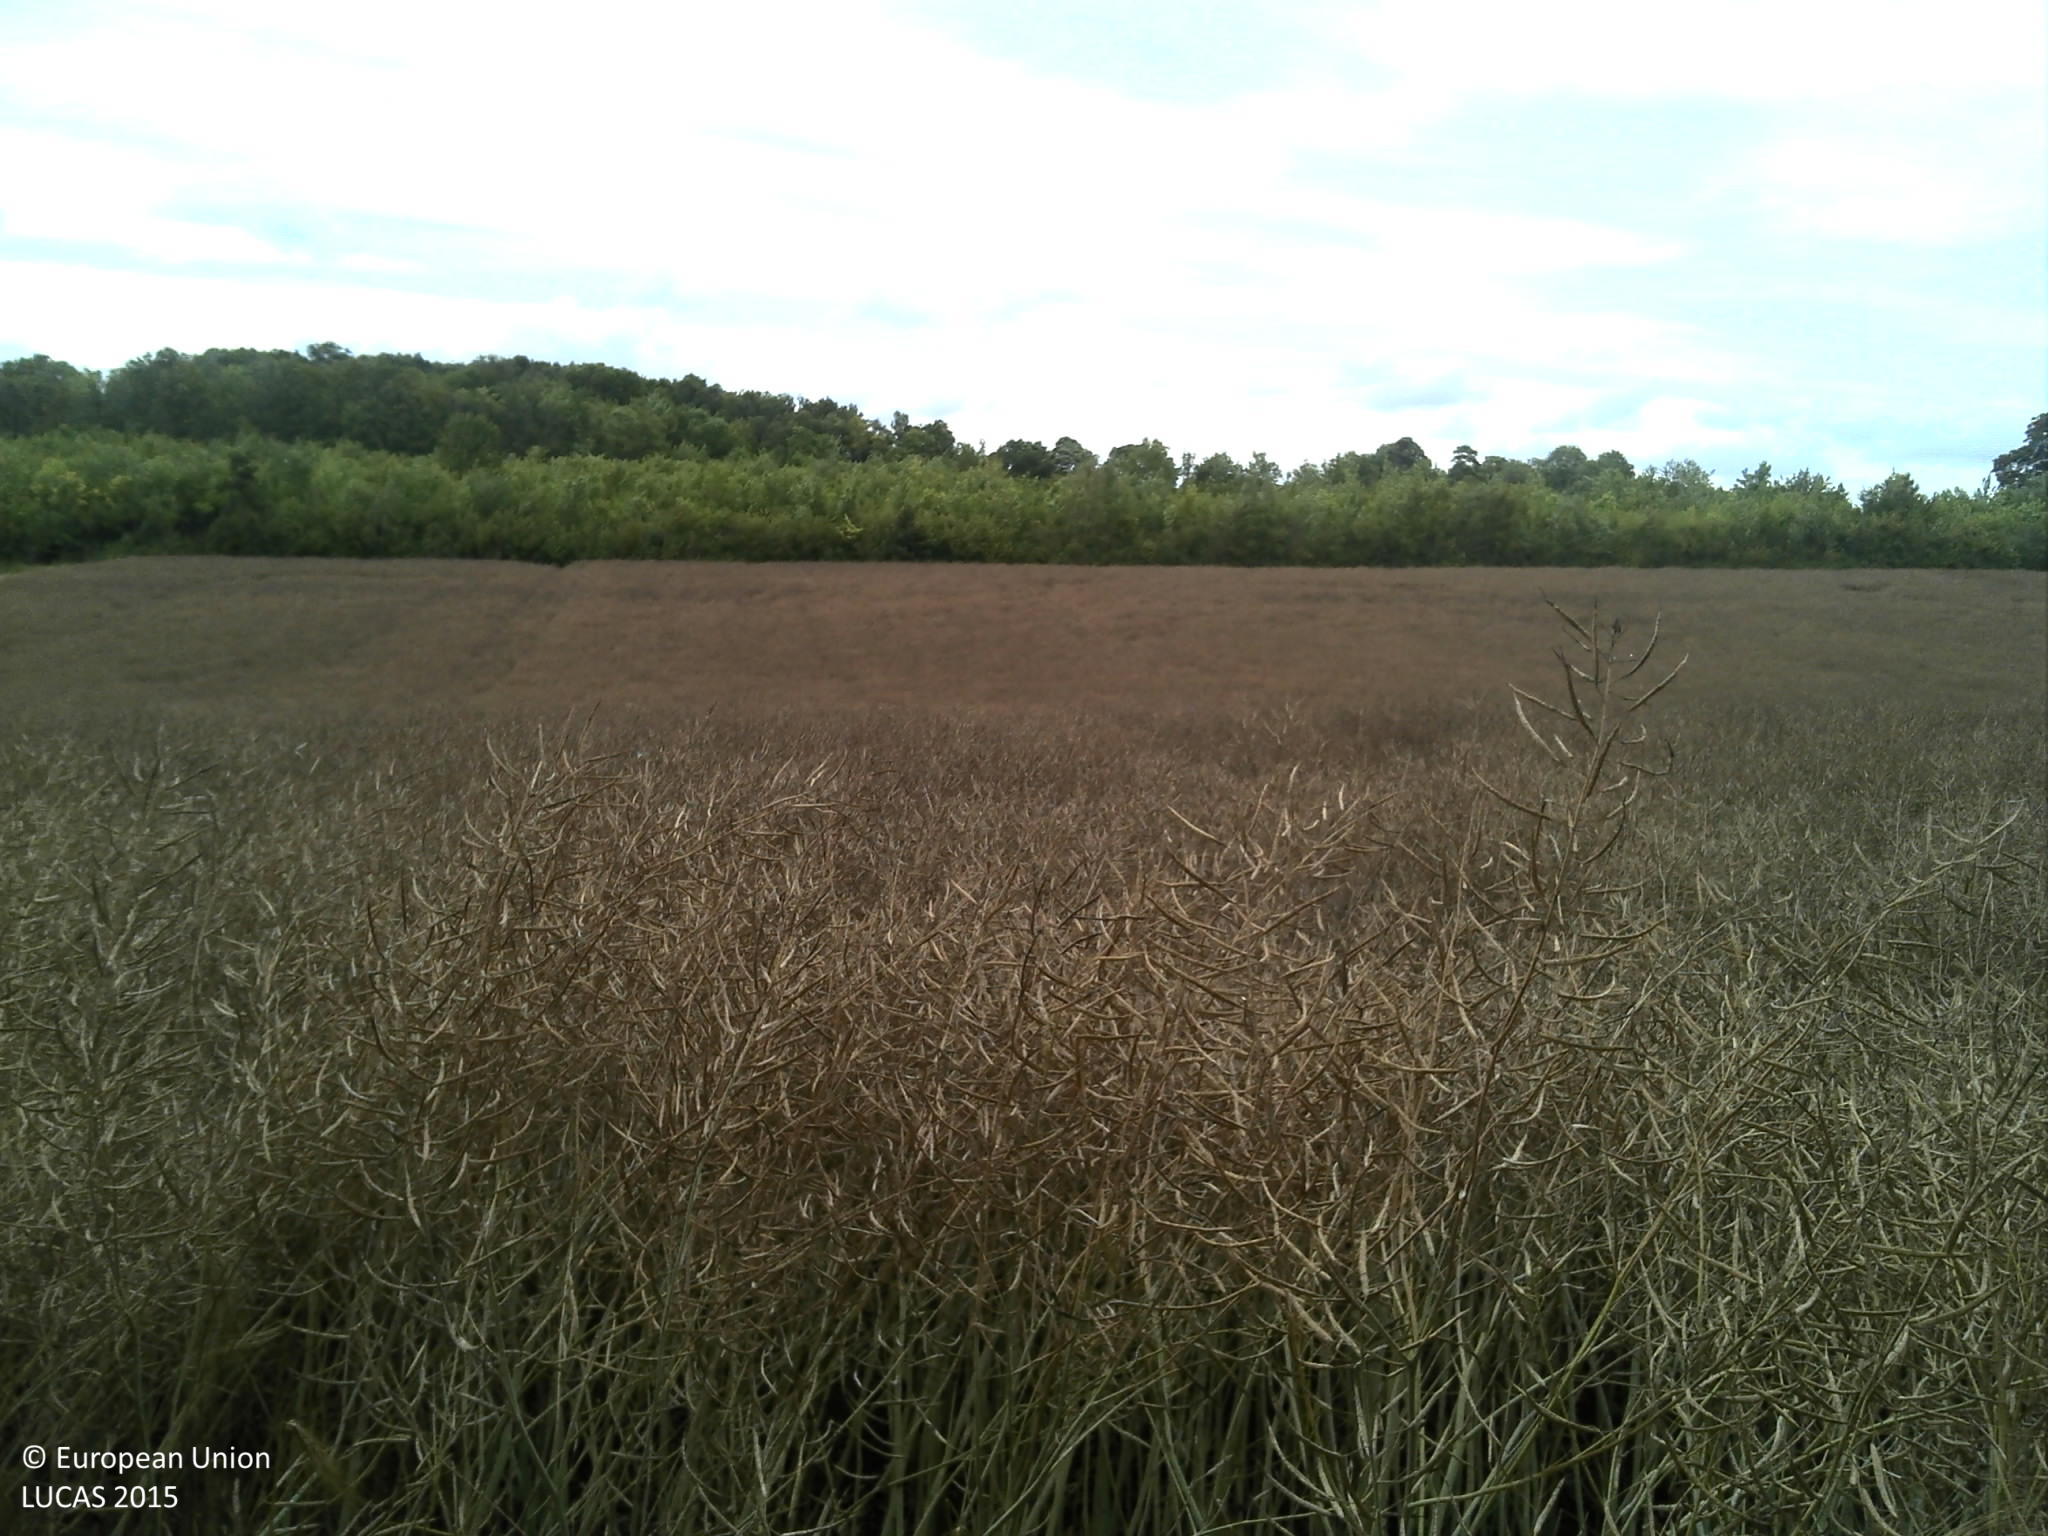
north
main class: Cropland
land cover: Rape and turnip rape
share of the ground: > 75 %
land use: Agriculture (excluding fallow land and kitchen gardens)
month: July
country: FR
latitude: 49.5472
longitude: 4.1487
